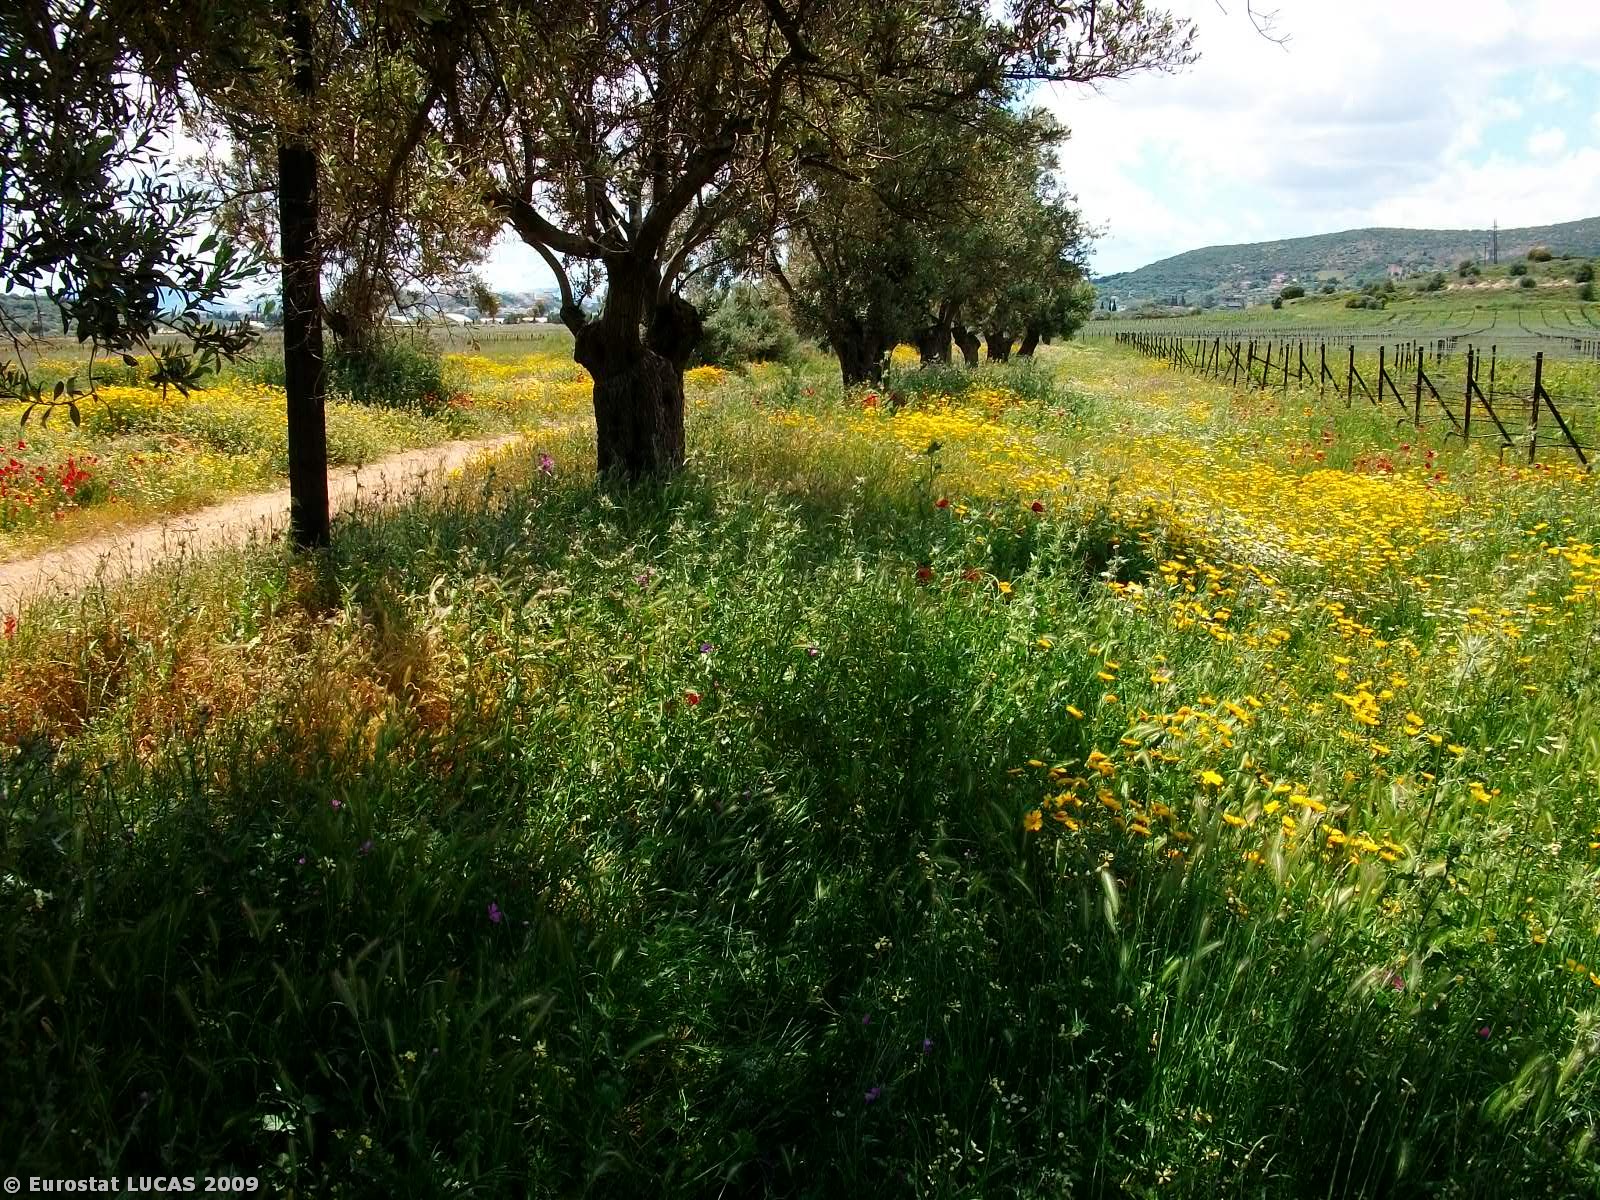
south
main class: Grassland
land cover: Grassland without tree/shrub cover
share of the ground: > 75 %
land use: Unused
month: May
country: GR
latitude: 37.9874
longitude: 23.9076
